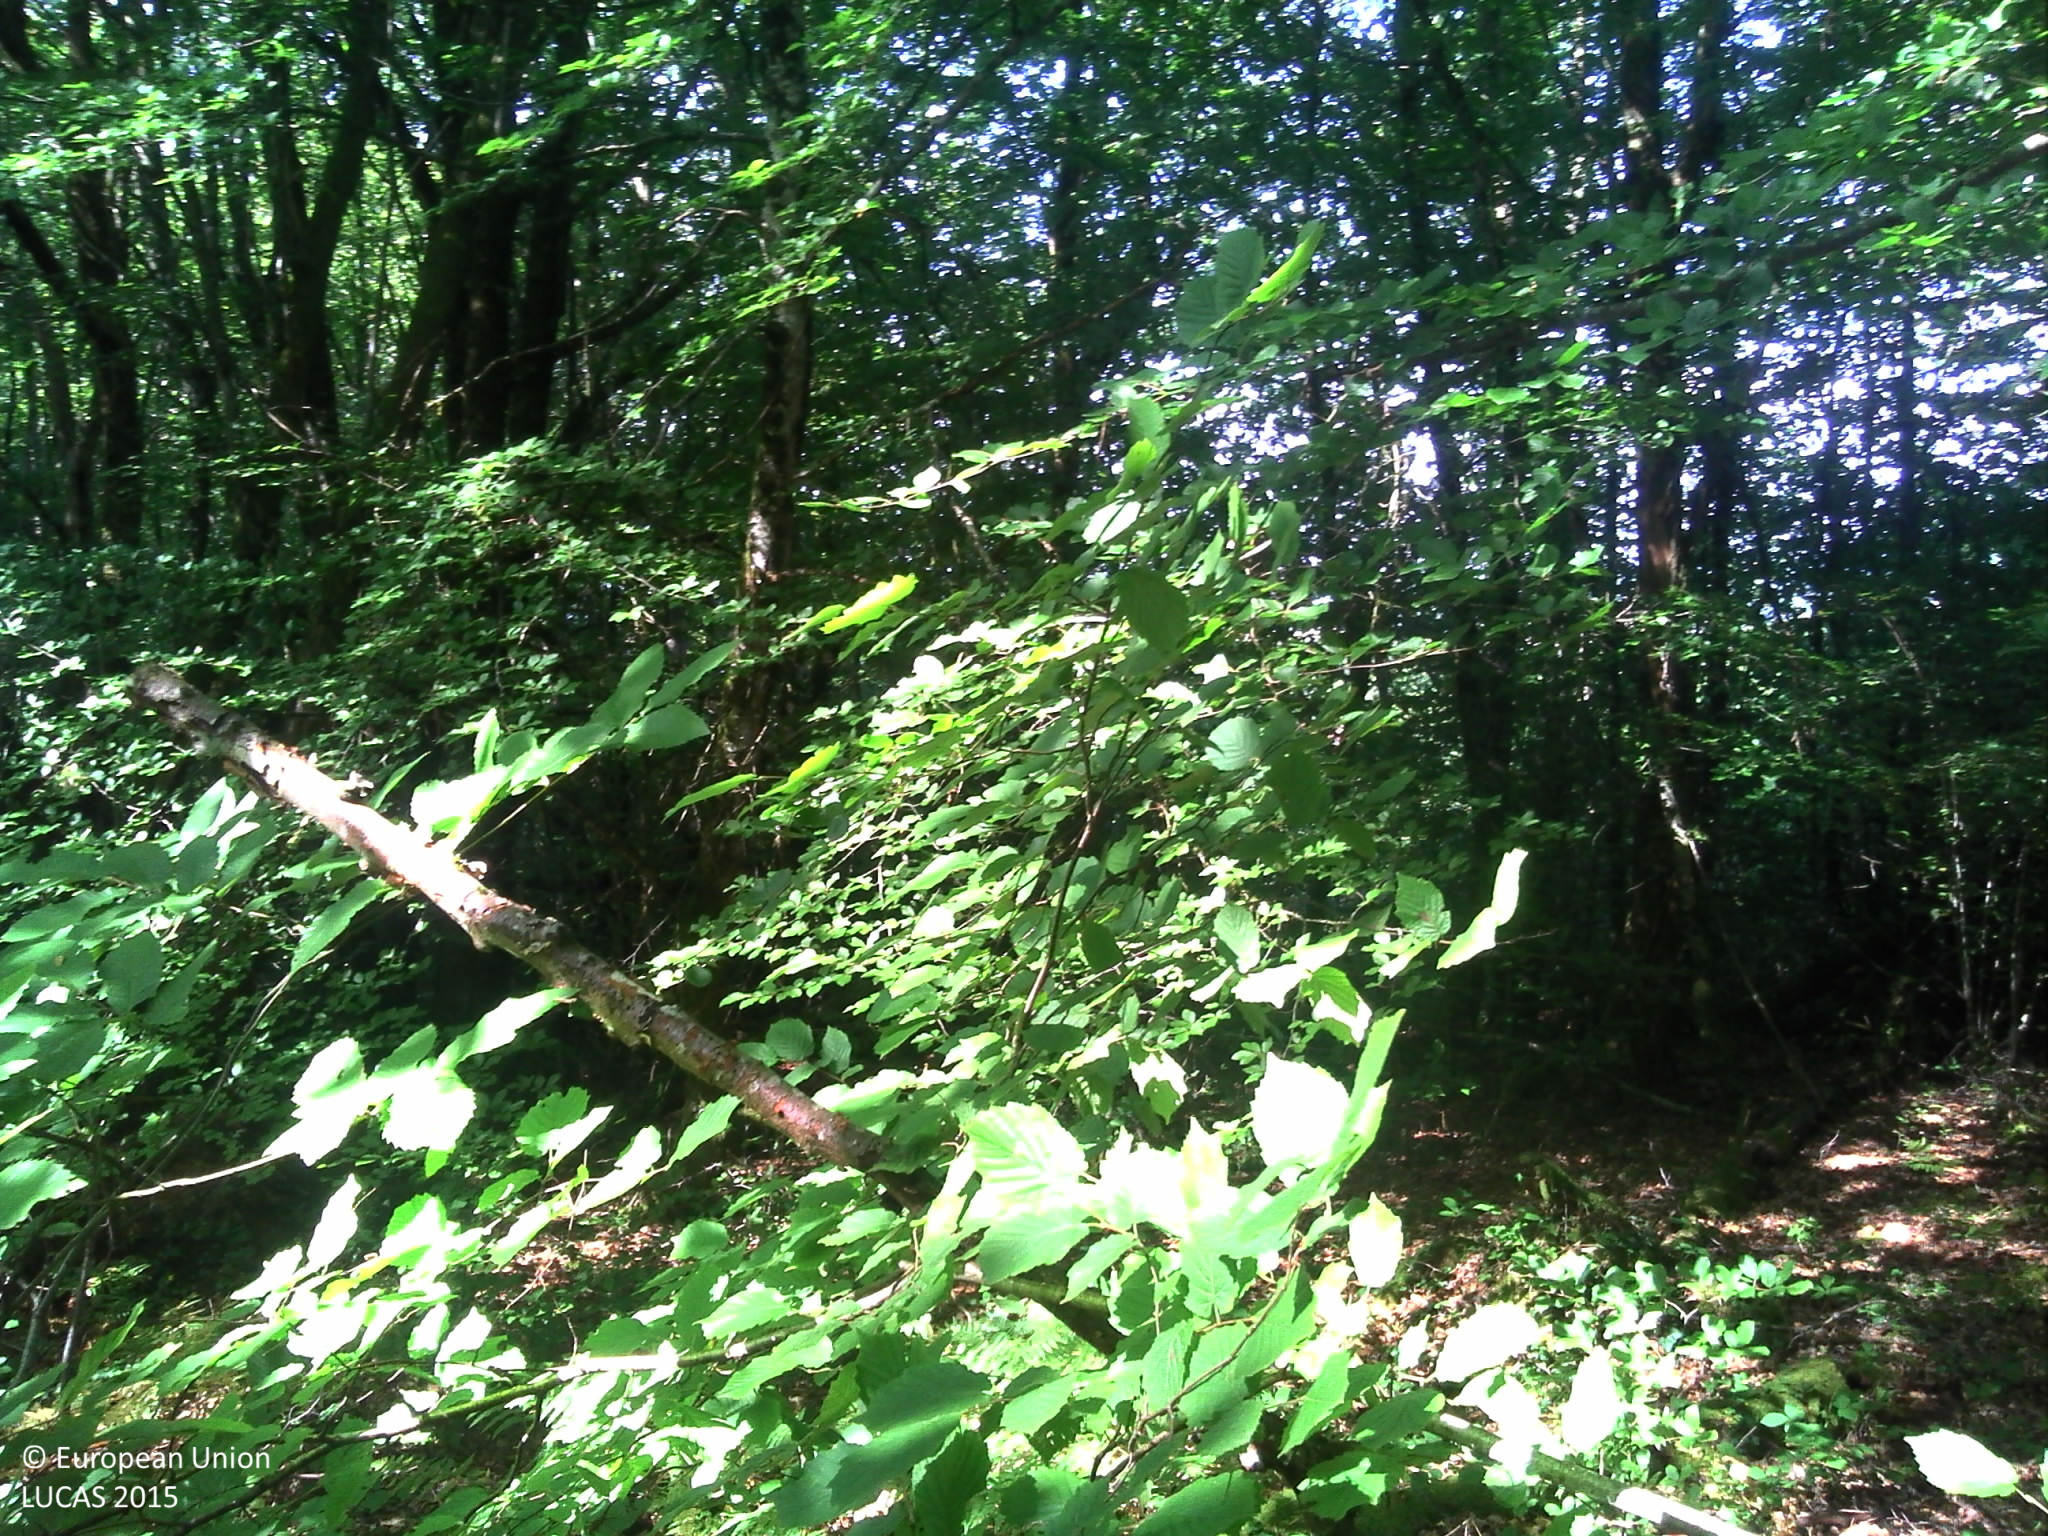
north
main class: Woodland
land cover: Broadleaved woodland
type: acidophilous oak and oak-birch forest
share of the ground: > 75 %
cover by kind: broadleaved forest trees 80 %, shrubs 10 %, herbaceous plants 5 %, lichens and mosses 5 %
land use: Forestry
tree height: > 5 m
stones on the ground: < 10 %
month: August
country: FR
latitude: 46.1067
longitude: 1.7776
